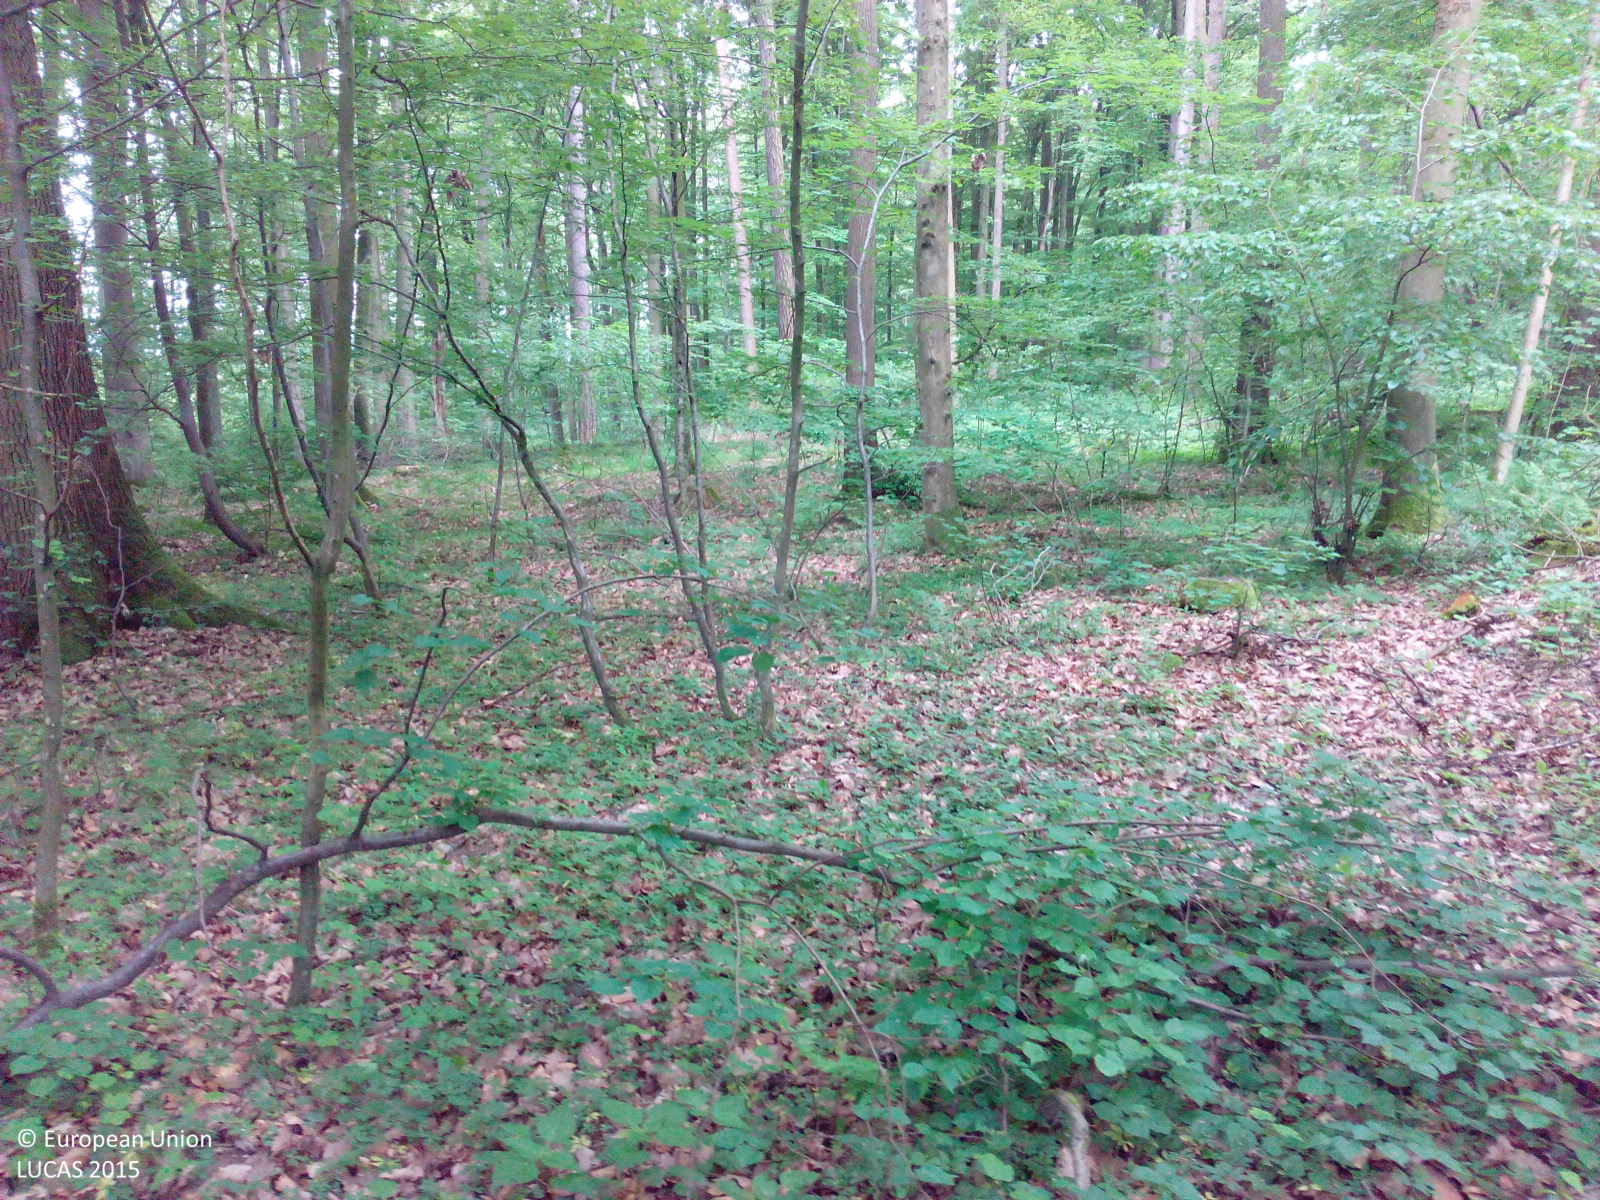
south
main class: Woodland
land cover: Broadleaved woodland
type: mesophytic deciduous forest
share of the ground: > 75 %
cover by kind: broadleaved forest trees 90 %, herbaceous plants 5 %, unconsolidated bare surface 5 %
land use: Forestry
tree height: > 5 m
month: May
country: DE
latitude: 48.6534
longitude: 9.3352
